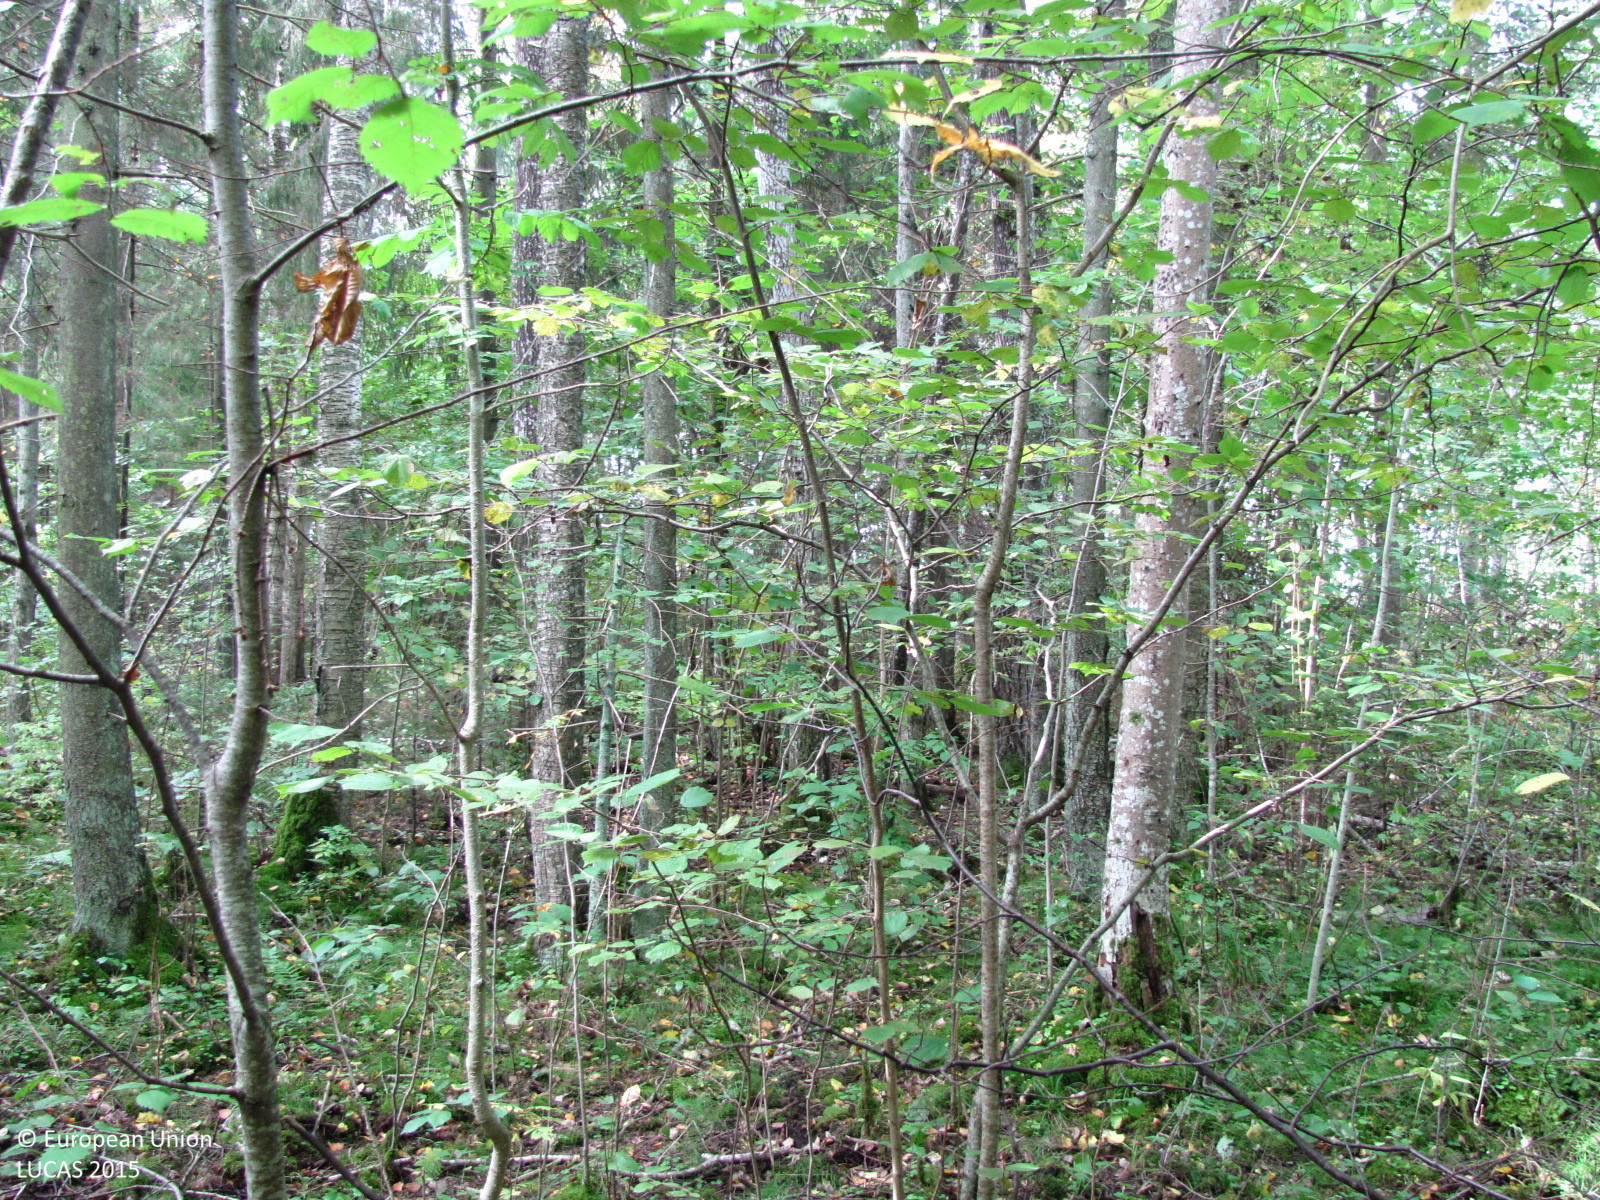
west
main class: Woodland
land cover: Spruce dominated mixed woodland
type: hemiboreal forest and nemoral coniferous forest and mixed broadleaved-coniferous forest
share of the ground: > 75 %
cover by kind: coniferous forest trees 40 %, broadleaved forest trees 40 %, herbaceous plants 10 %, lichens and mosses 10 %
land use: Forestry
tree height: > 5 m
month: September
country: LV
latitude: 56.7278
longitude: 25.1629
